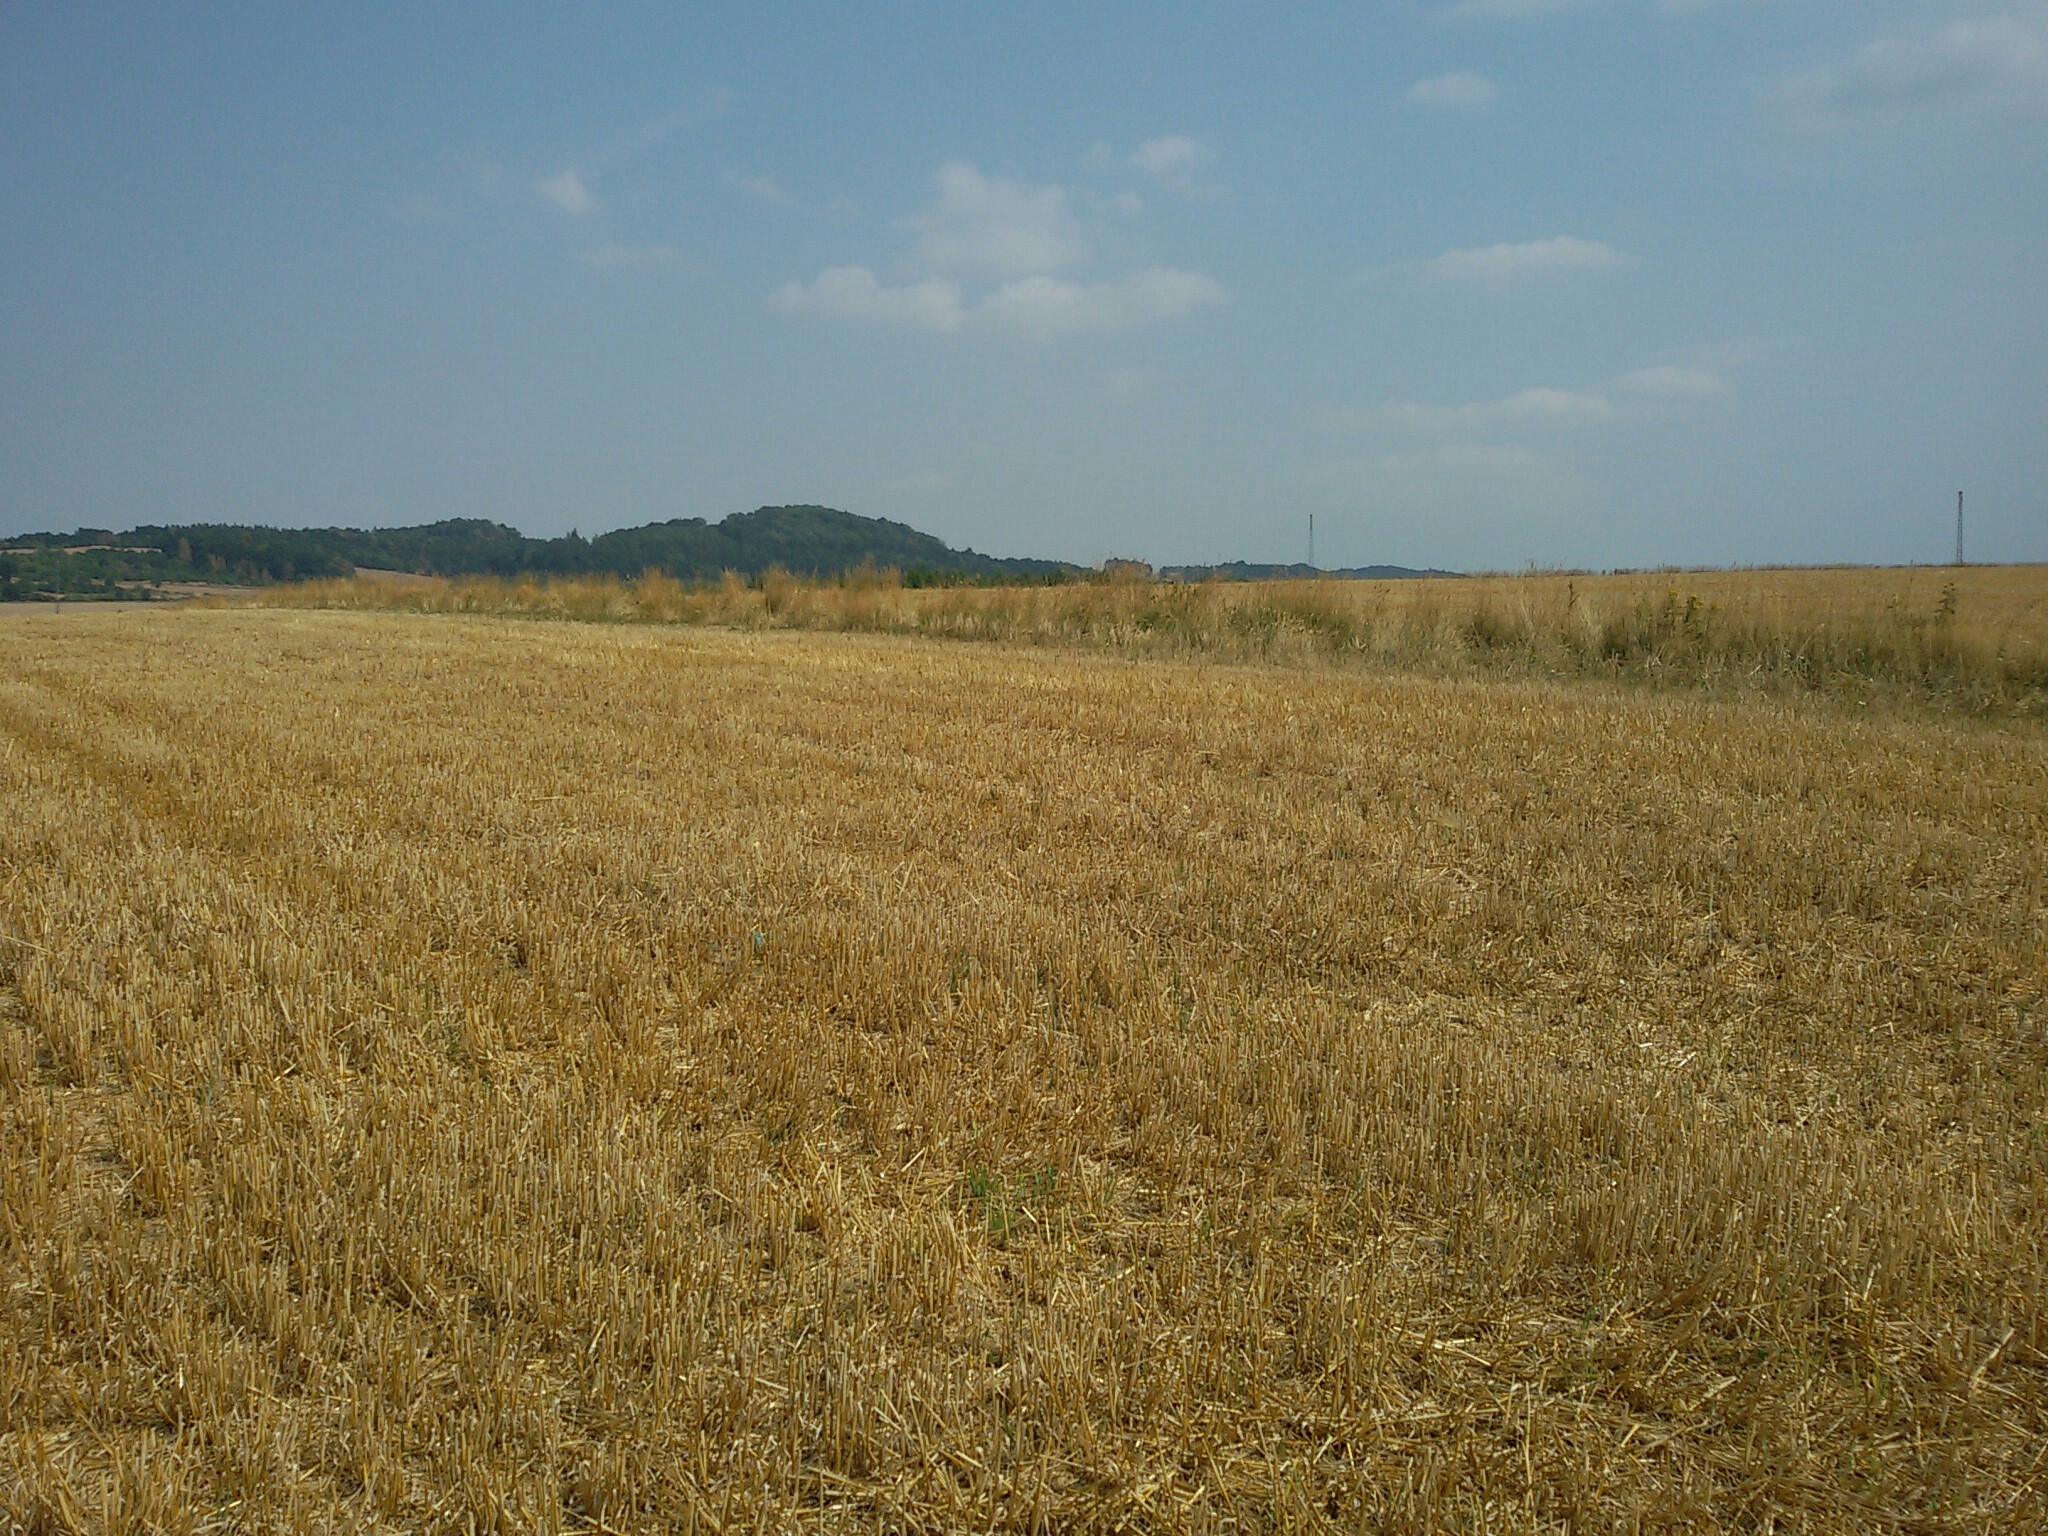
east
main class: Cropland
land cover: Triticale
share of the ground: > 75 %
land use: Agriculture (excluding fallow land and kitchen gardens)
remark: Harvested field
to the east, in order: Triticale; Tracks; Grass margins; Barley
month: August
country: PL
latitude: 51.0334
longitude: 15.6946
